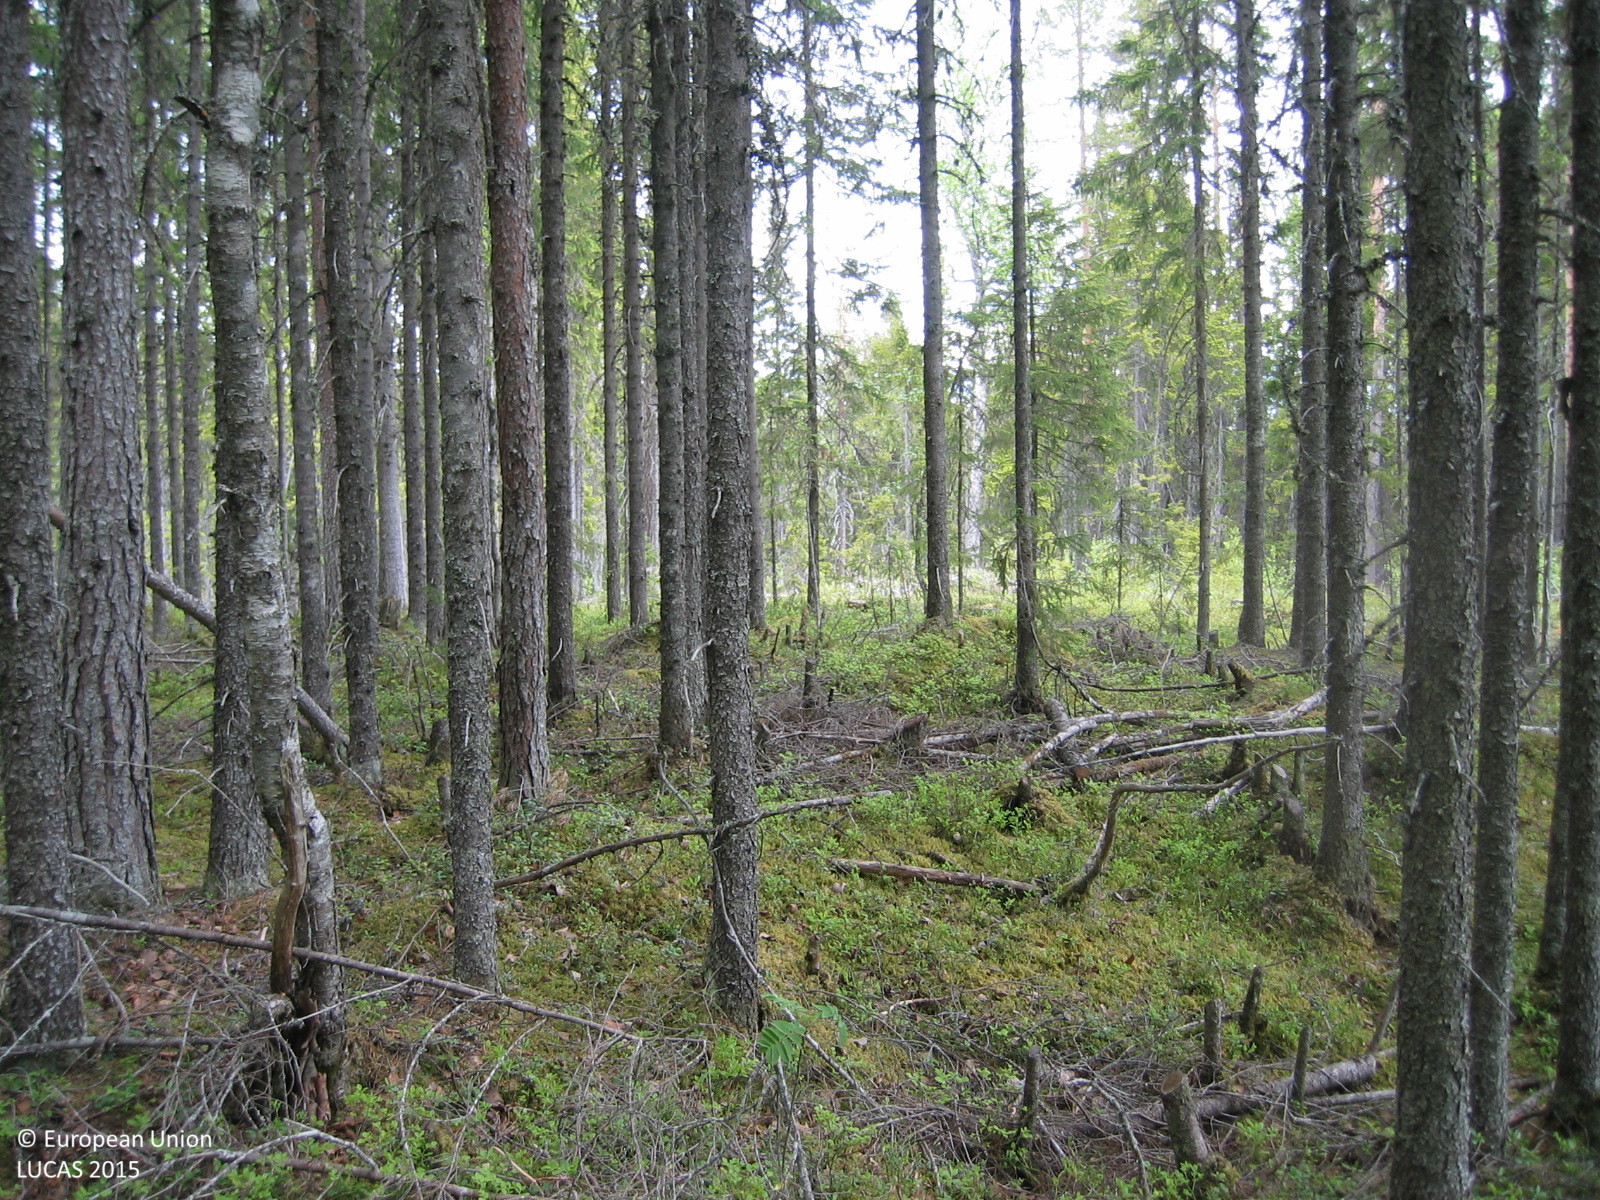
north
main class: Woodland
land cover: Spruce dominated coniferous woodland
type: boreal forest
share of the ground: > 75 %
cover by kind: coniferous forest trees 85 %, shrubs 10 %, broadleaved forest trees 5 %
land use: Forestry
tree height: > 5 m
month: June
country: SE
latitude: 63.5699
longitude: 14.6690
